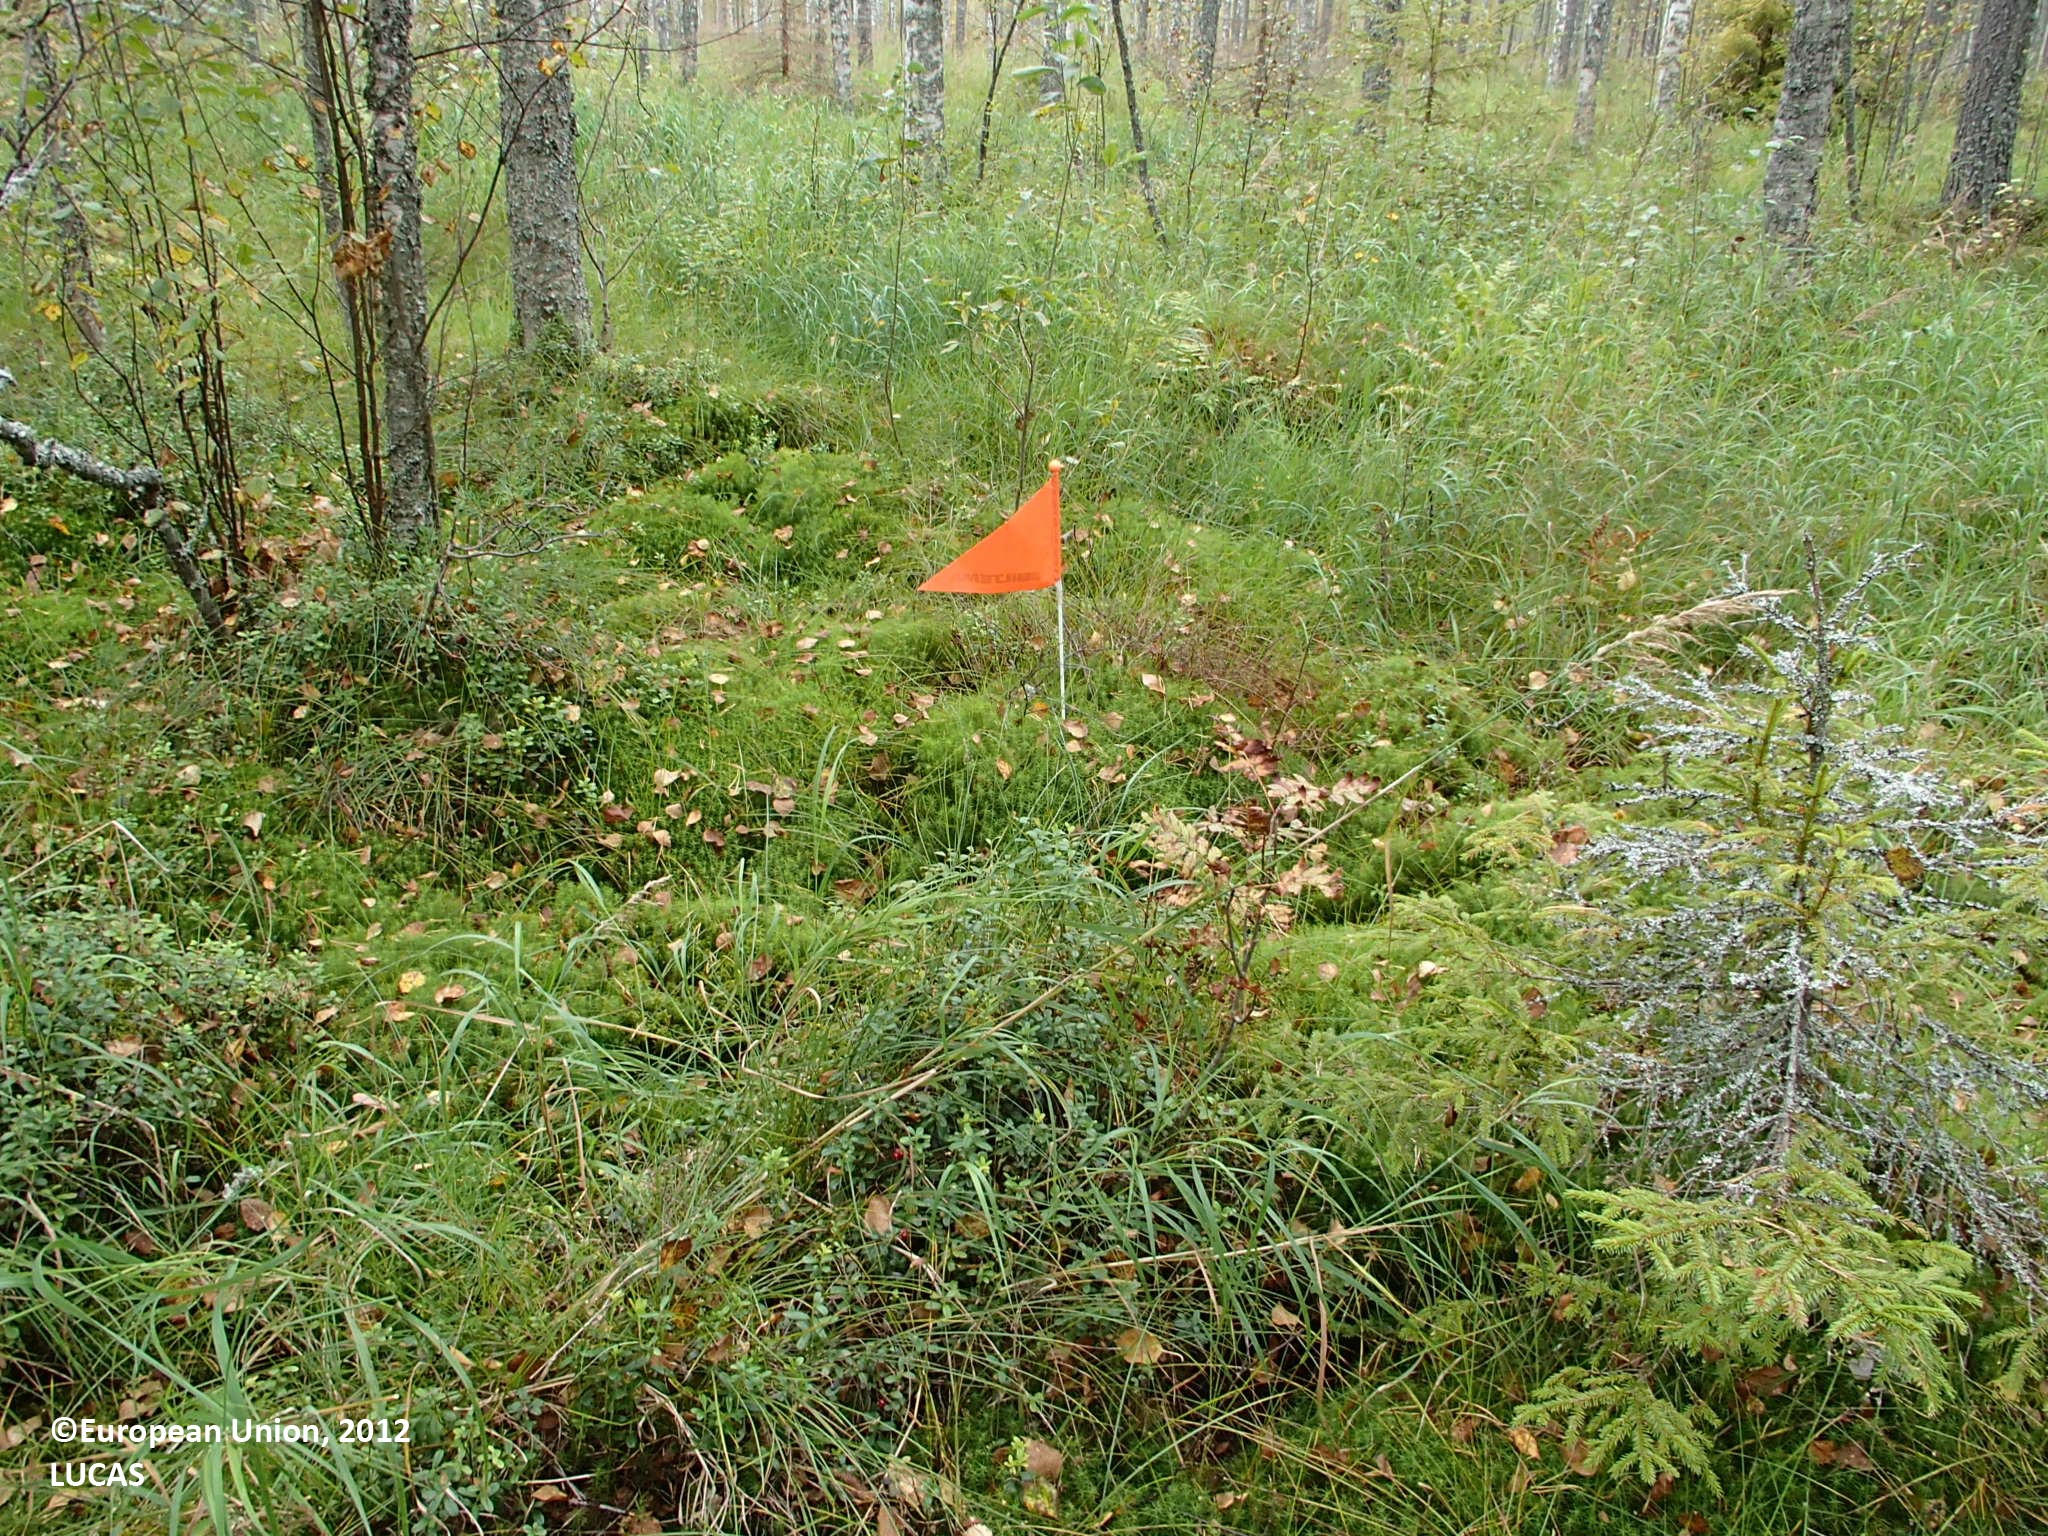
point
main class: Woodland
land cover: Pine dominated mixed woodland
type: boreal forest
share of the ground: 50 - 75 %
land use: Forestry
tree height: > 5 m
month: September
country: FI
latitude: 63.8481
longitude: 26.0749
